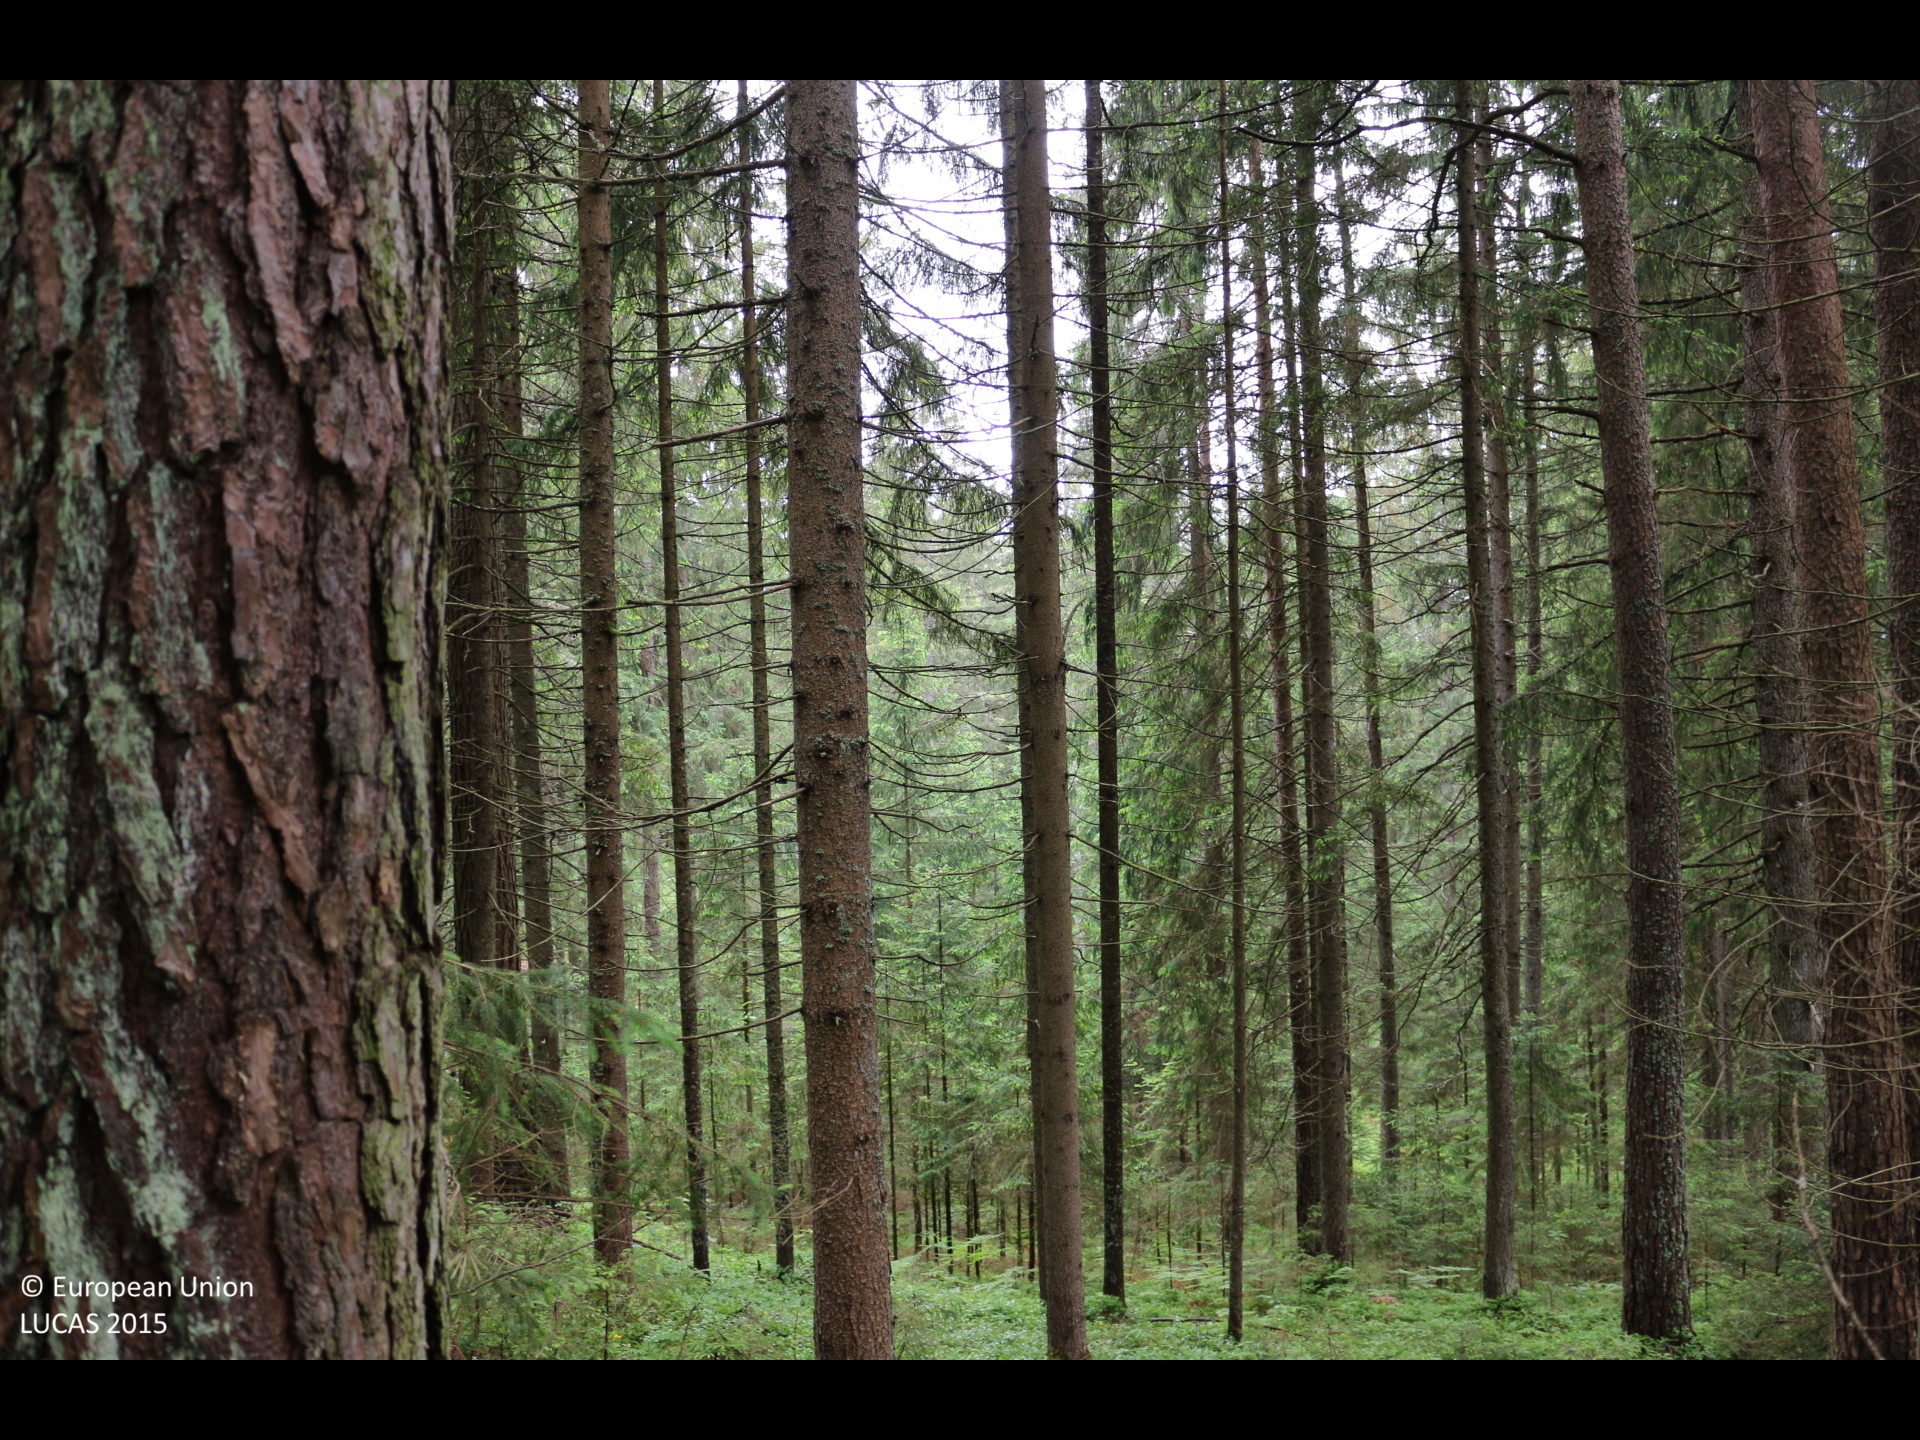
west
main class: Woodland
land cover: Spruce dominated coniferous woodland
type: alpine coniferous forest
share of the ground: > 75 %
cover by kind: coniferous forest trees 95 %, broadleaved forest trees 5 %
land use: Forestry
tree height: > 5 m
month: May
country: AT
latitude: 46.6868
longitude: 14.1161
